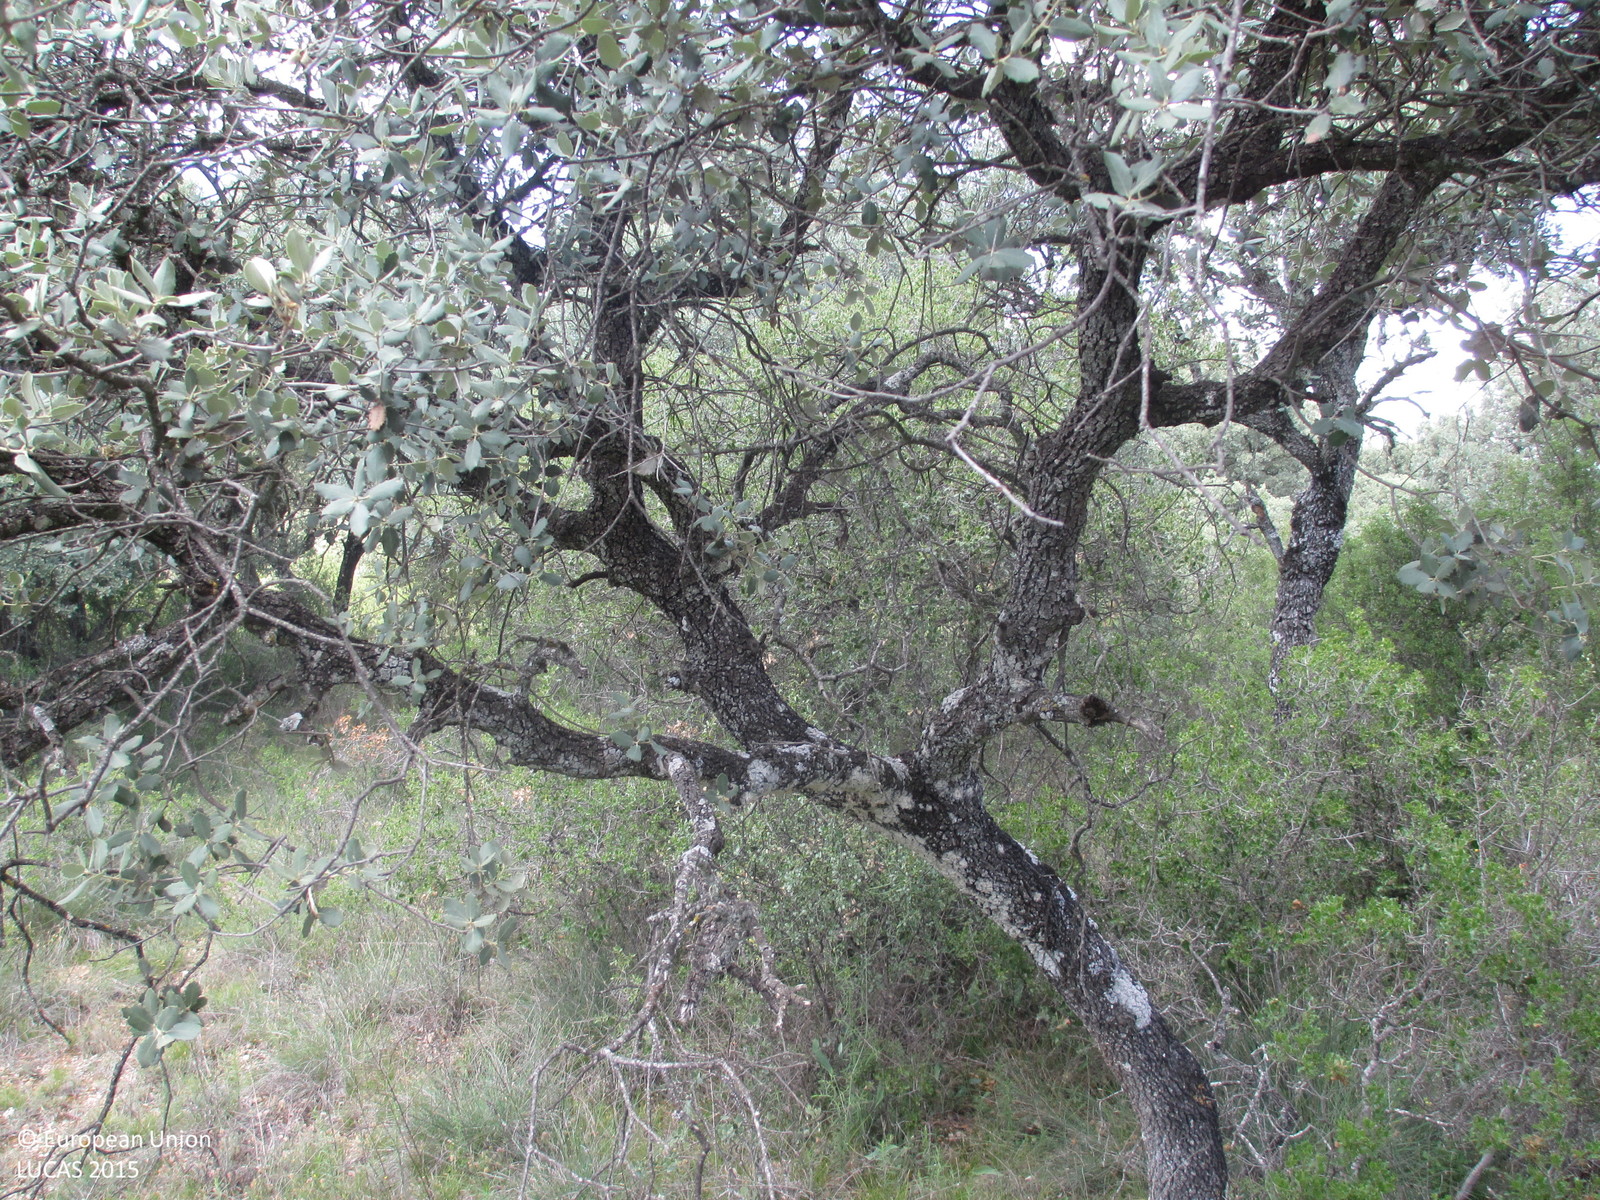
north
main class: Woodland
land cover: Broadleaved woodland
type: broadleaved evergreen forest
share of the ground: > 75 %
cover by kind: broadleaved forest trees 100 %
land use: Semi-natural and natural areas not in use
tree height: > 5 m
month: June
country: ES
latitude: 42.2004
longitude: -0.4752
